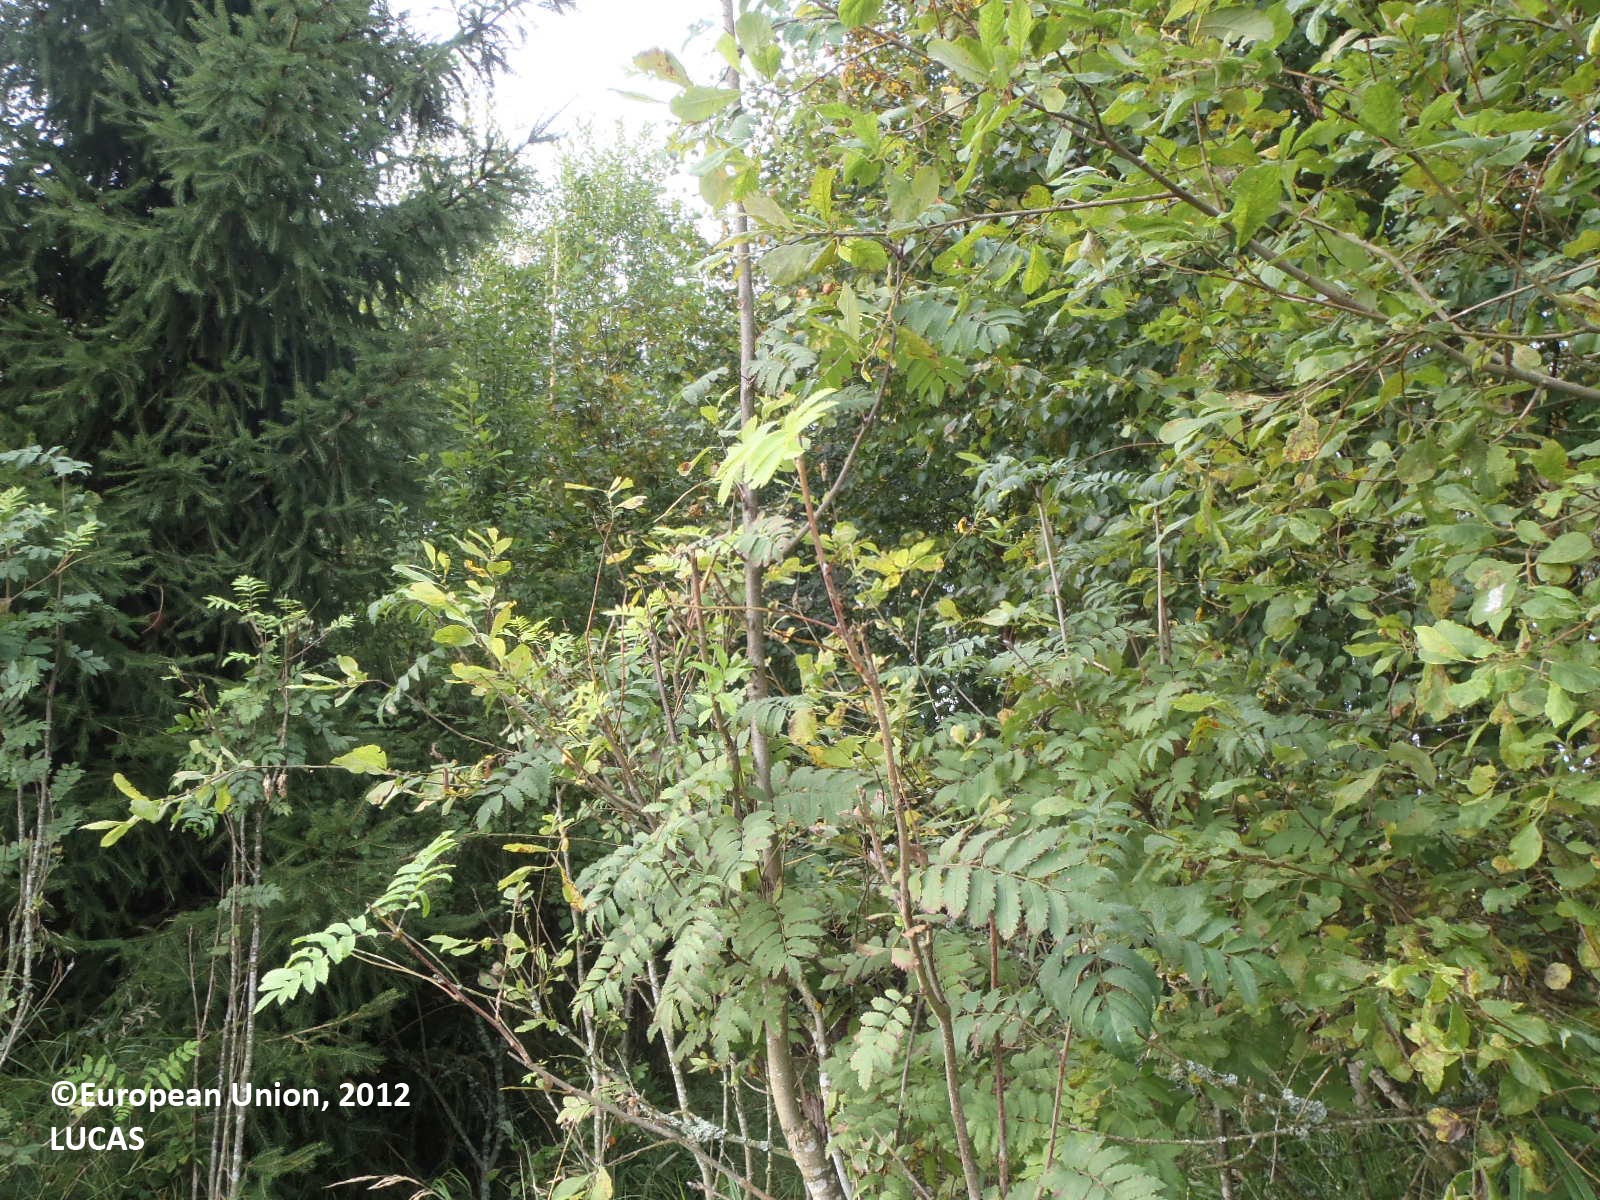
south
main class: Cropland
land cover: Common wheat
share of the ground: > 75 %
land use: Agriculture (excluding fallow land and kitchen gardens)
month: September
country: FI
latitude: 60.8130
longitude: 22.6630
